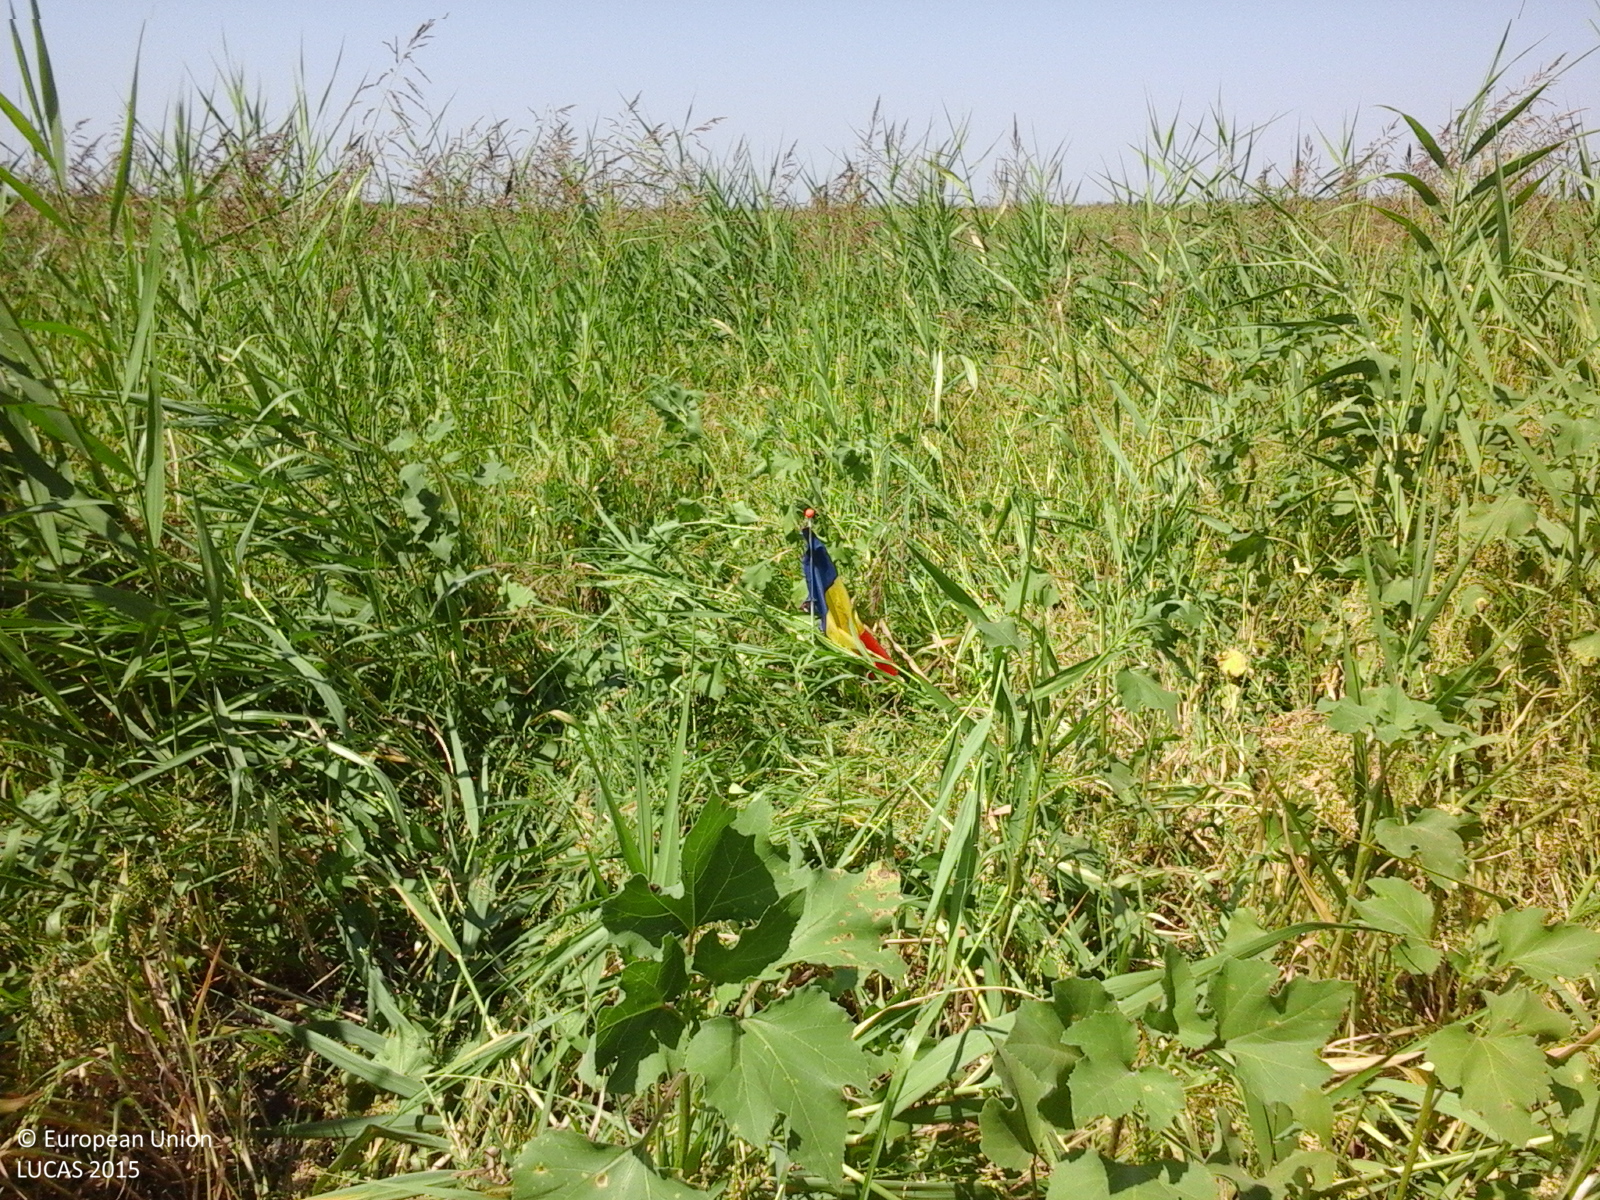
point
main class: Grassland
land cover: Spontaneously vegetated surfaces
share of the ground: > 75 %
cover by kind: herbaceous plants 100 %
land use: Fallow land
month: July
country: RO
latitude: 45.0383
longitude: 27.1883
